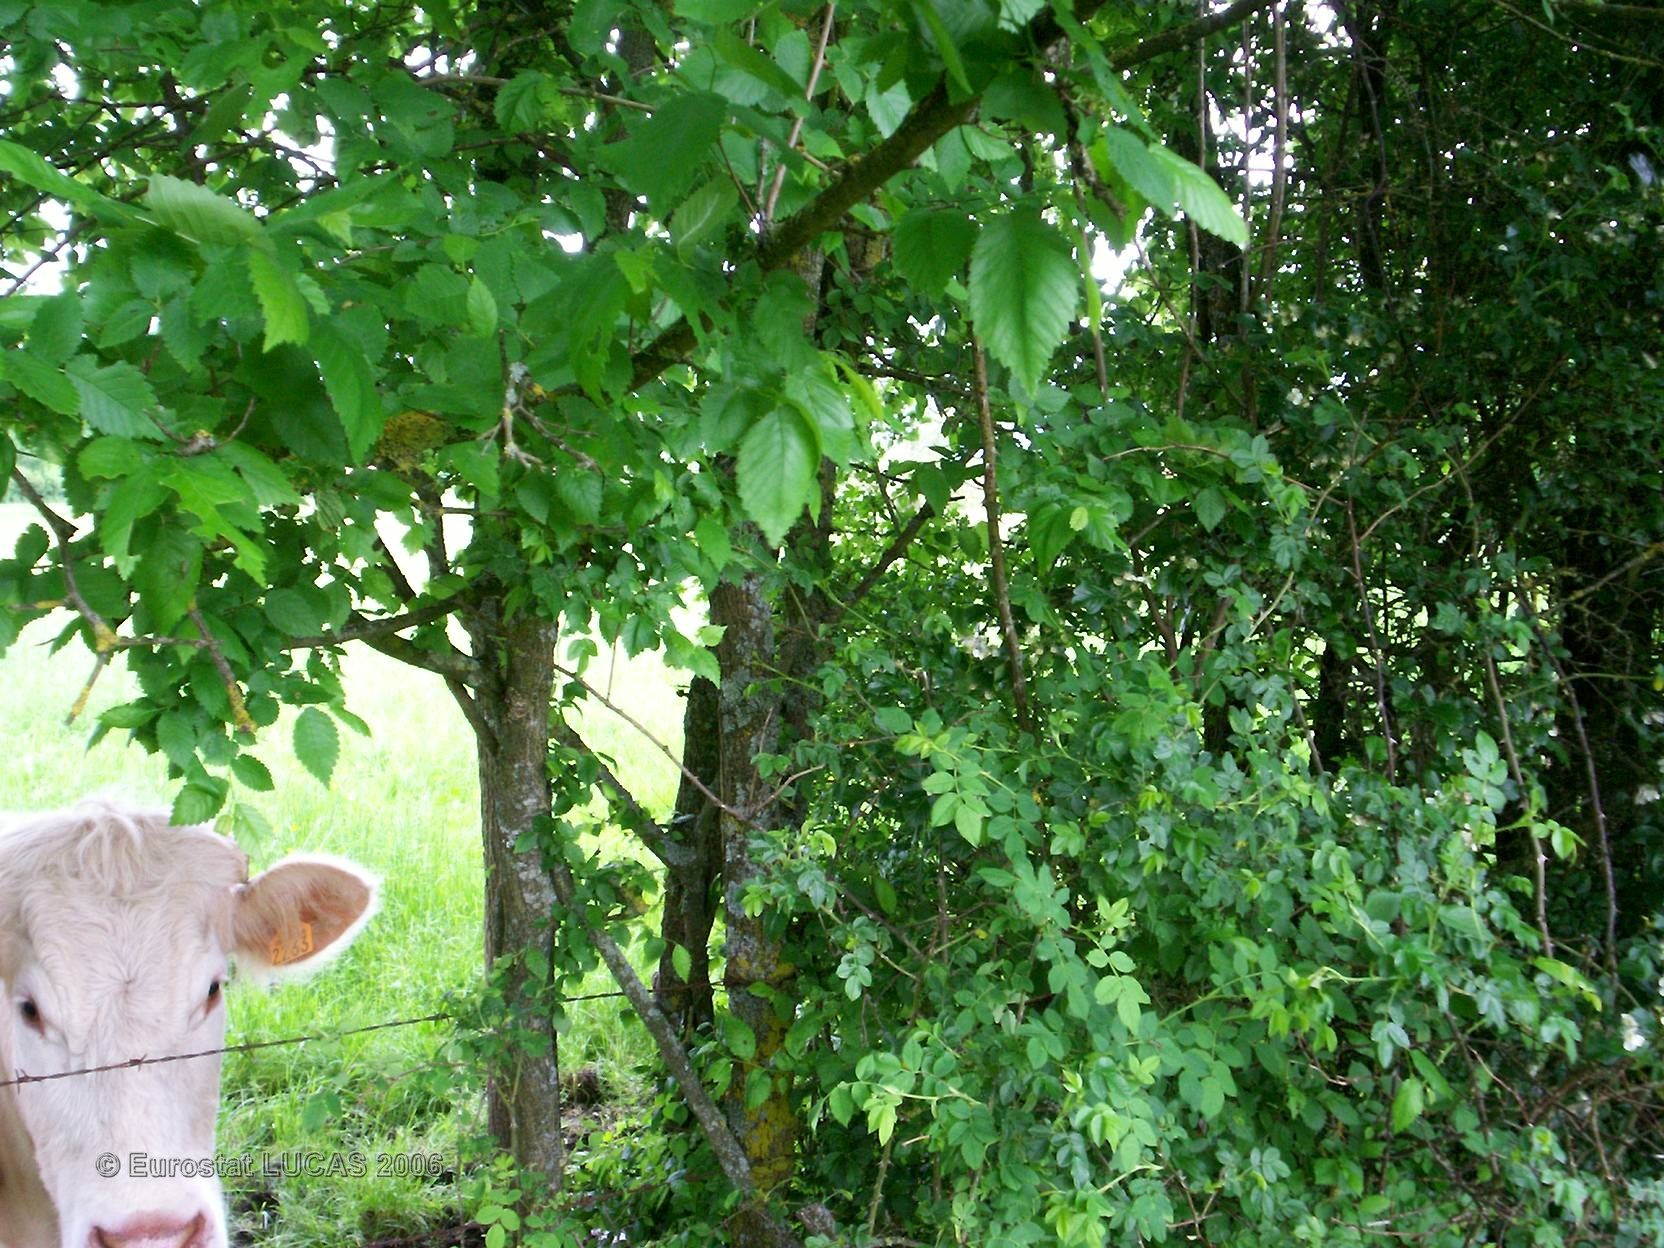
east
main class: Grassland
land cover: Grassland without tree/shrub cover
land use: Agriculture (excluding fallow land and kitchen gardens)
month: May
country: FR
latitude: 46.3138
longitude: 5.1589
